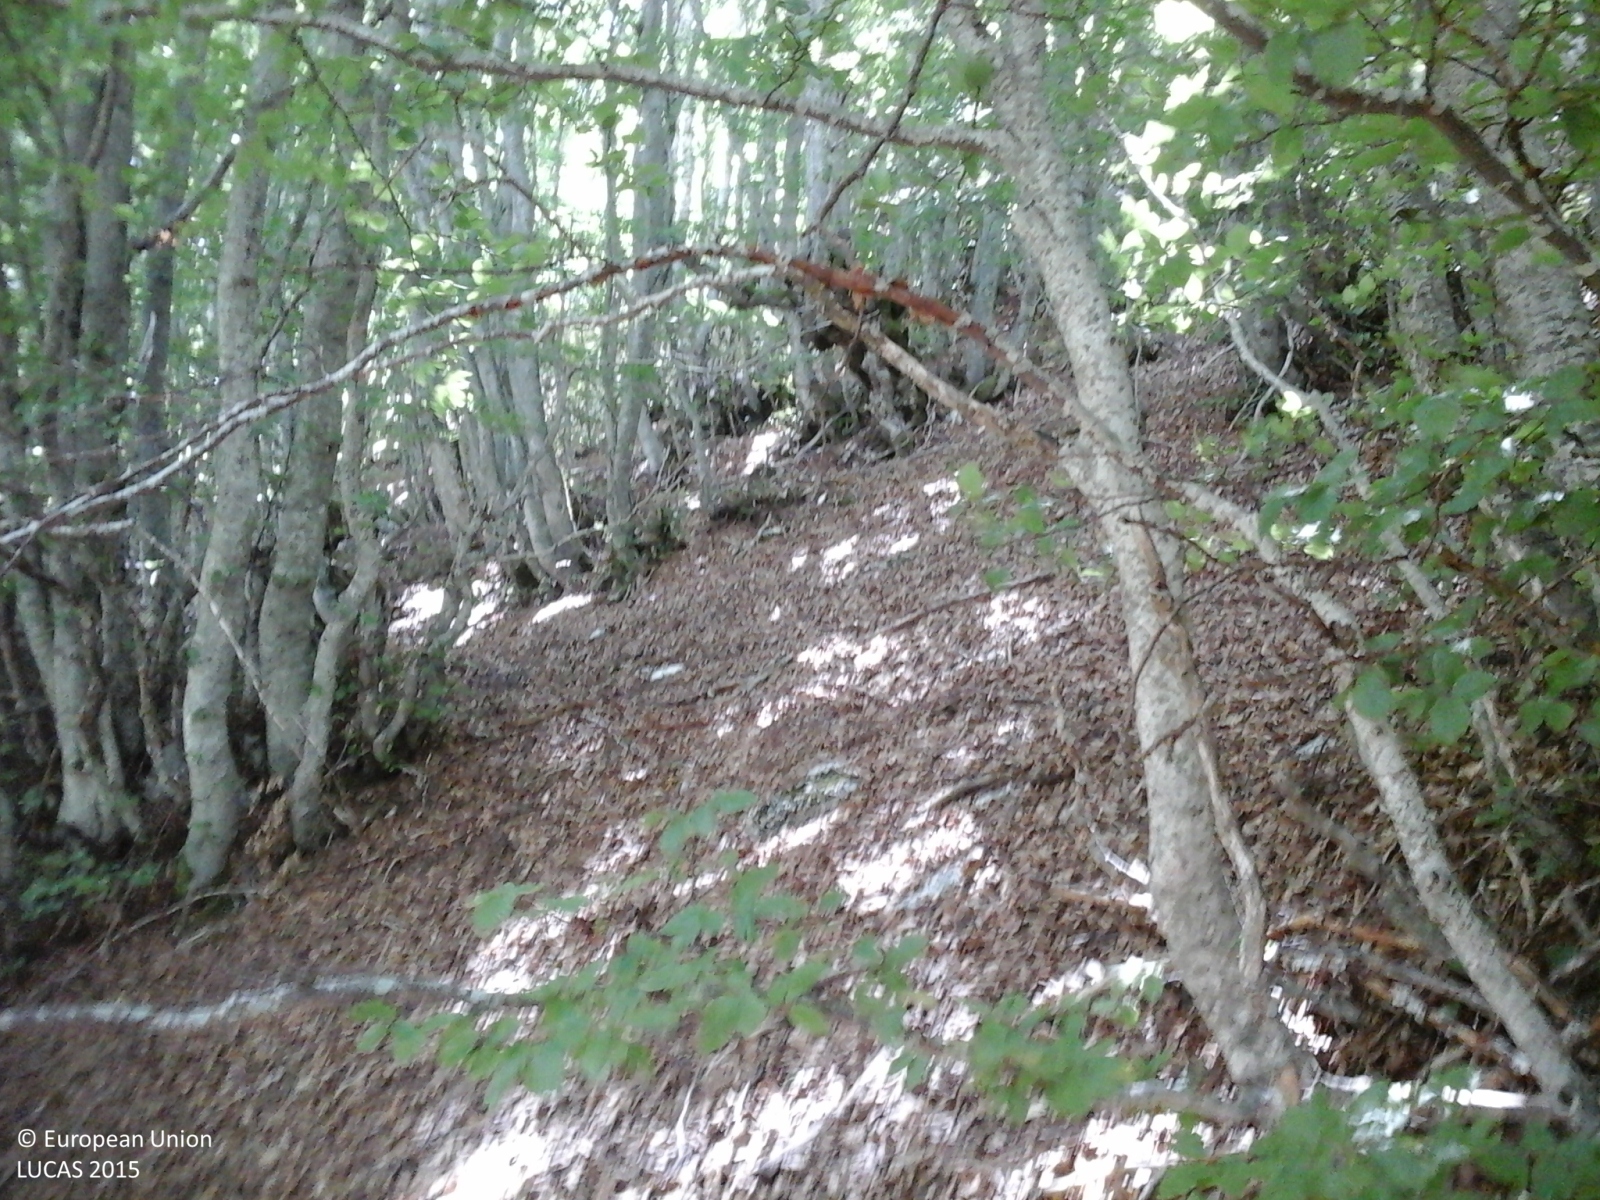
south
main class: Woodland
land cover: Broadleaved woodland
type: mountainous beech forest
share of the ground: > 75 %
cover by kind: broadleaved forest trees 100 %
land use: Forestry
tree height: > 5 m
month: August
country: IT
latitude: 42.8562
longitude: 13.2093
